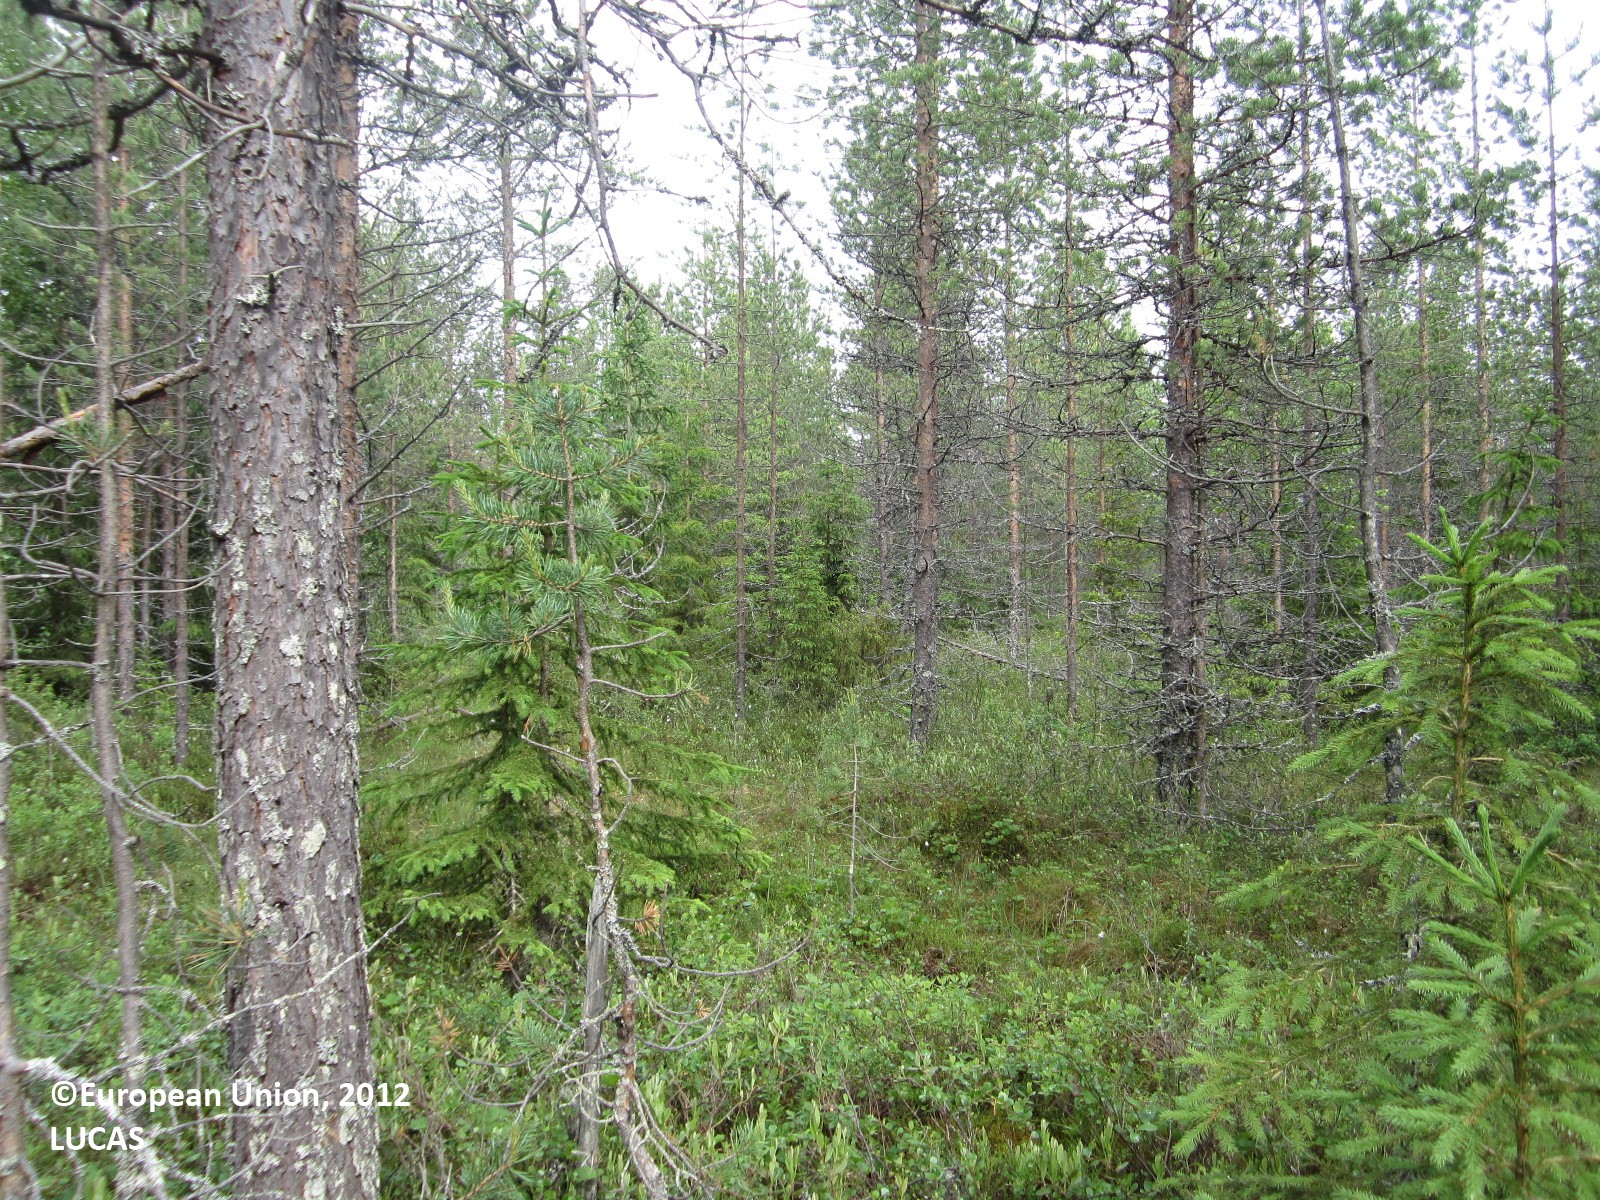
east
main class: Woodland
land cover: Pine dominated coniferous woodland
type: boreal forest
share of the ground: 50 - 75 %
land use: Forestry
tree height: > 5 m
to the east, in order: Pine dominated coniferous woodland; Ditches and canals; Pine dominated coniferous woodland; Broadleaved woodland; Ditches and canals; Broadleaved woodland; Ditches and canals; Broadleaved woodland; Pine dominated mixed woodland; Ditches and canals; Pine dominated mixed woodland
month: June
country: FI
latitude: 64.4846
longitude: 29.7618
